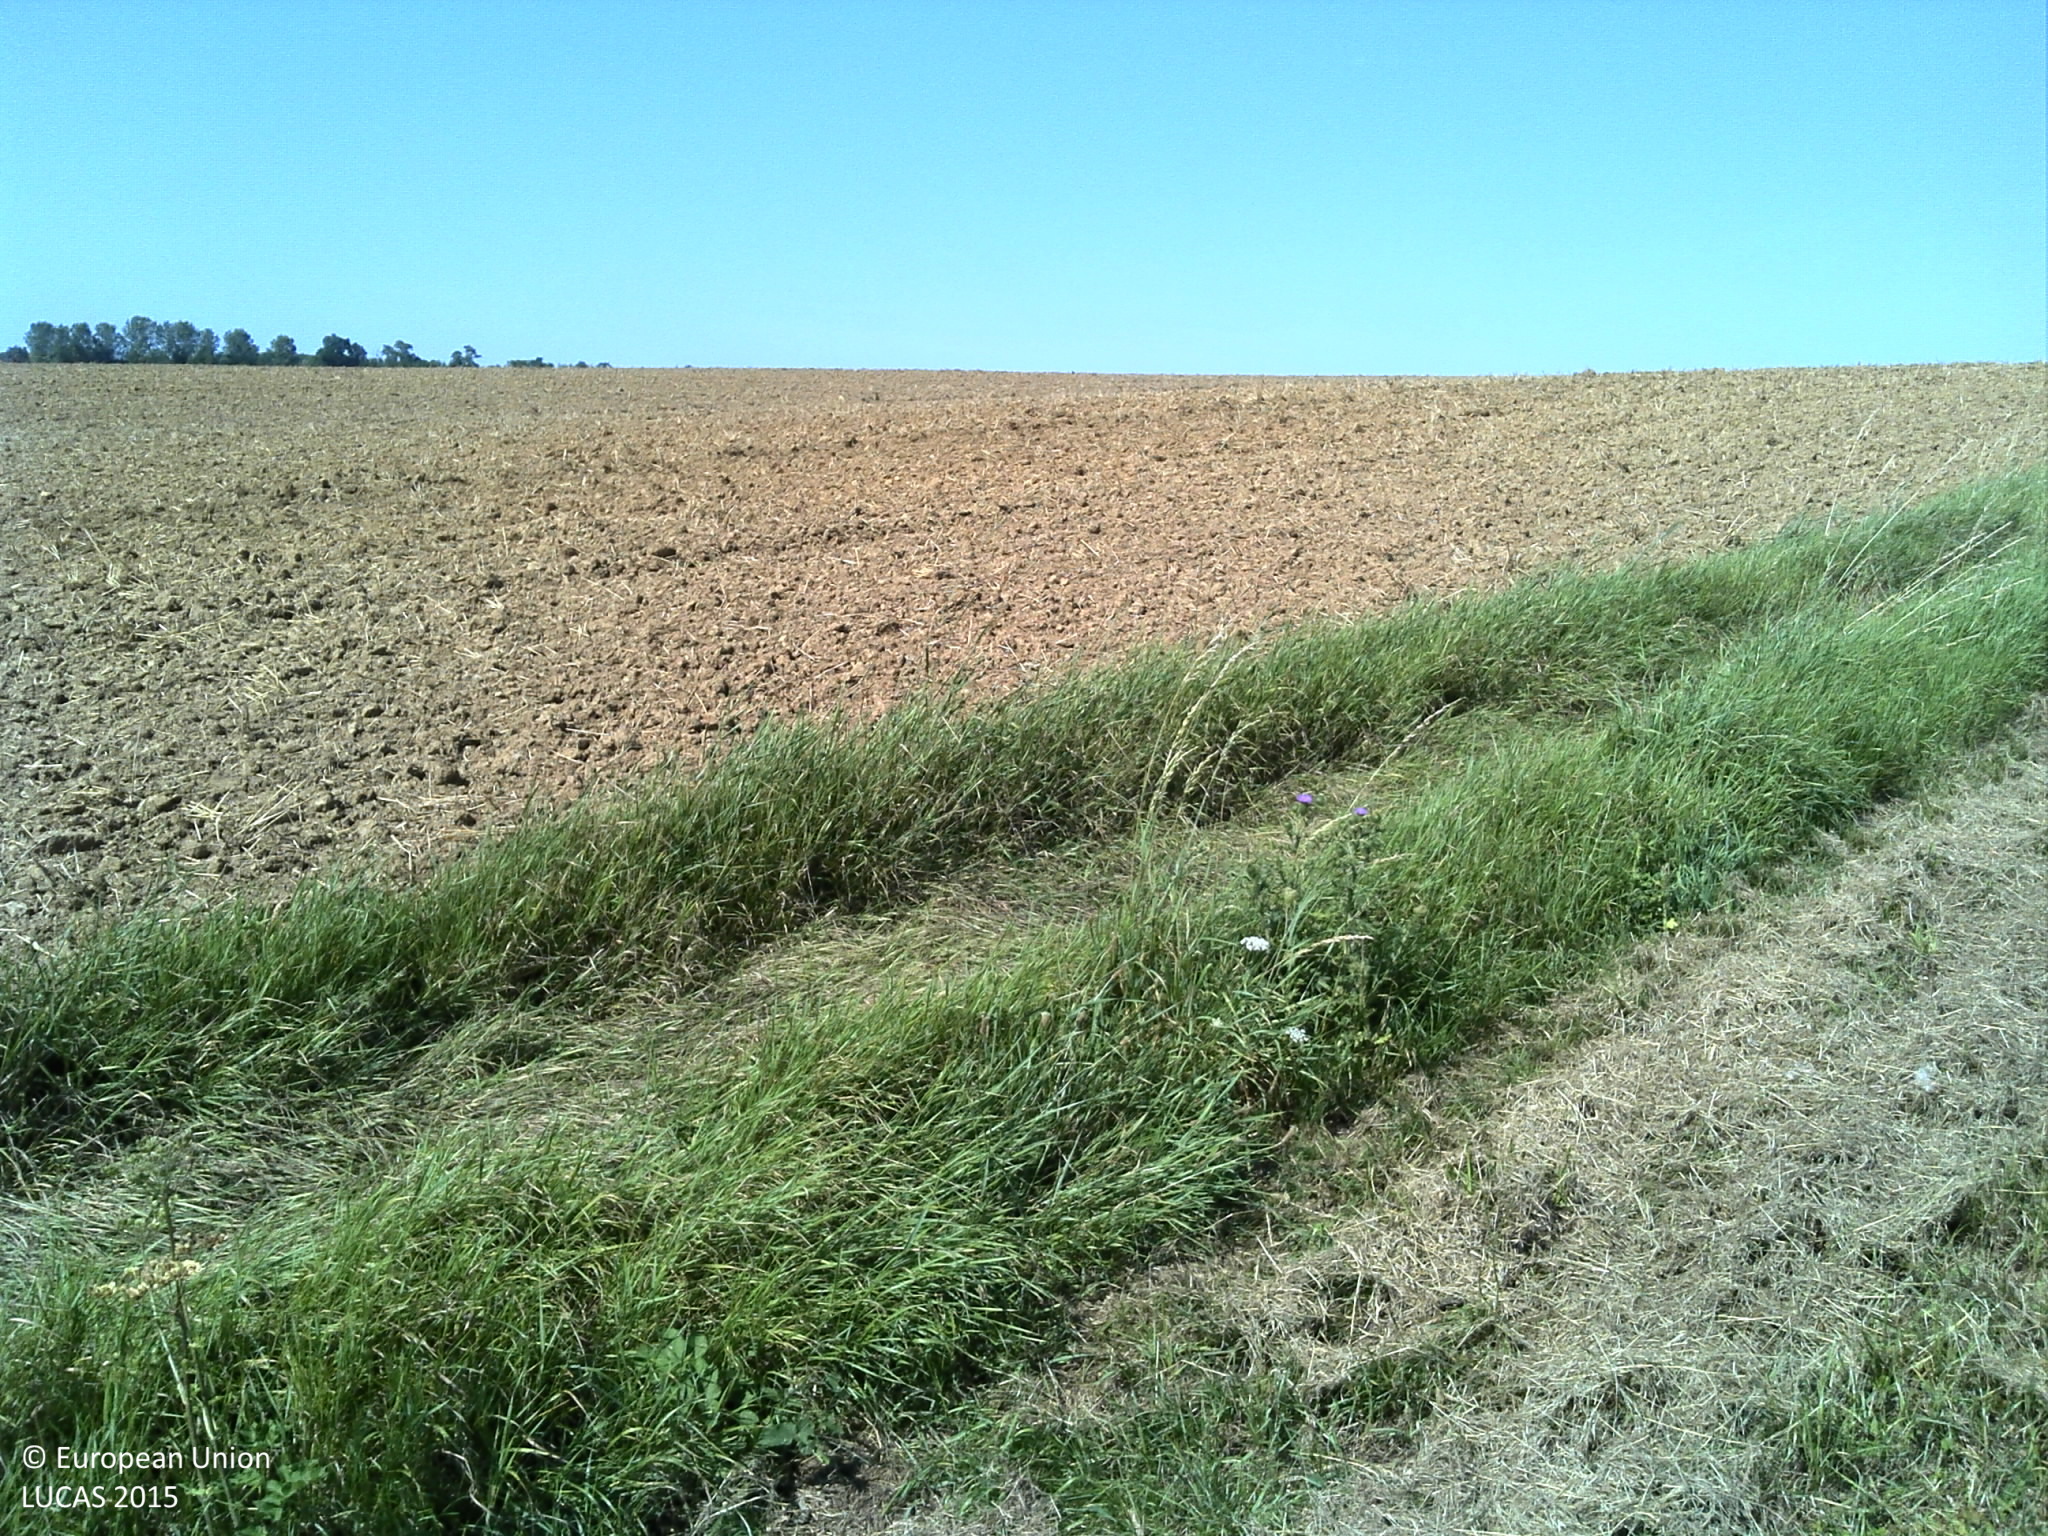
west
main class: Cropland
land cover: Rape and turnip rape
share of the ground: 10 - 25 %
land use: Agriculture (excluding fallow land and kitchen gardens)
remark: Harvested field
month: August
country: FR
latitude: 50.0136
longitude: 3.1390
